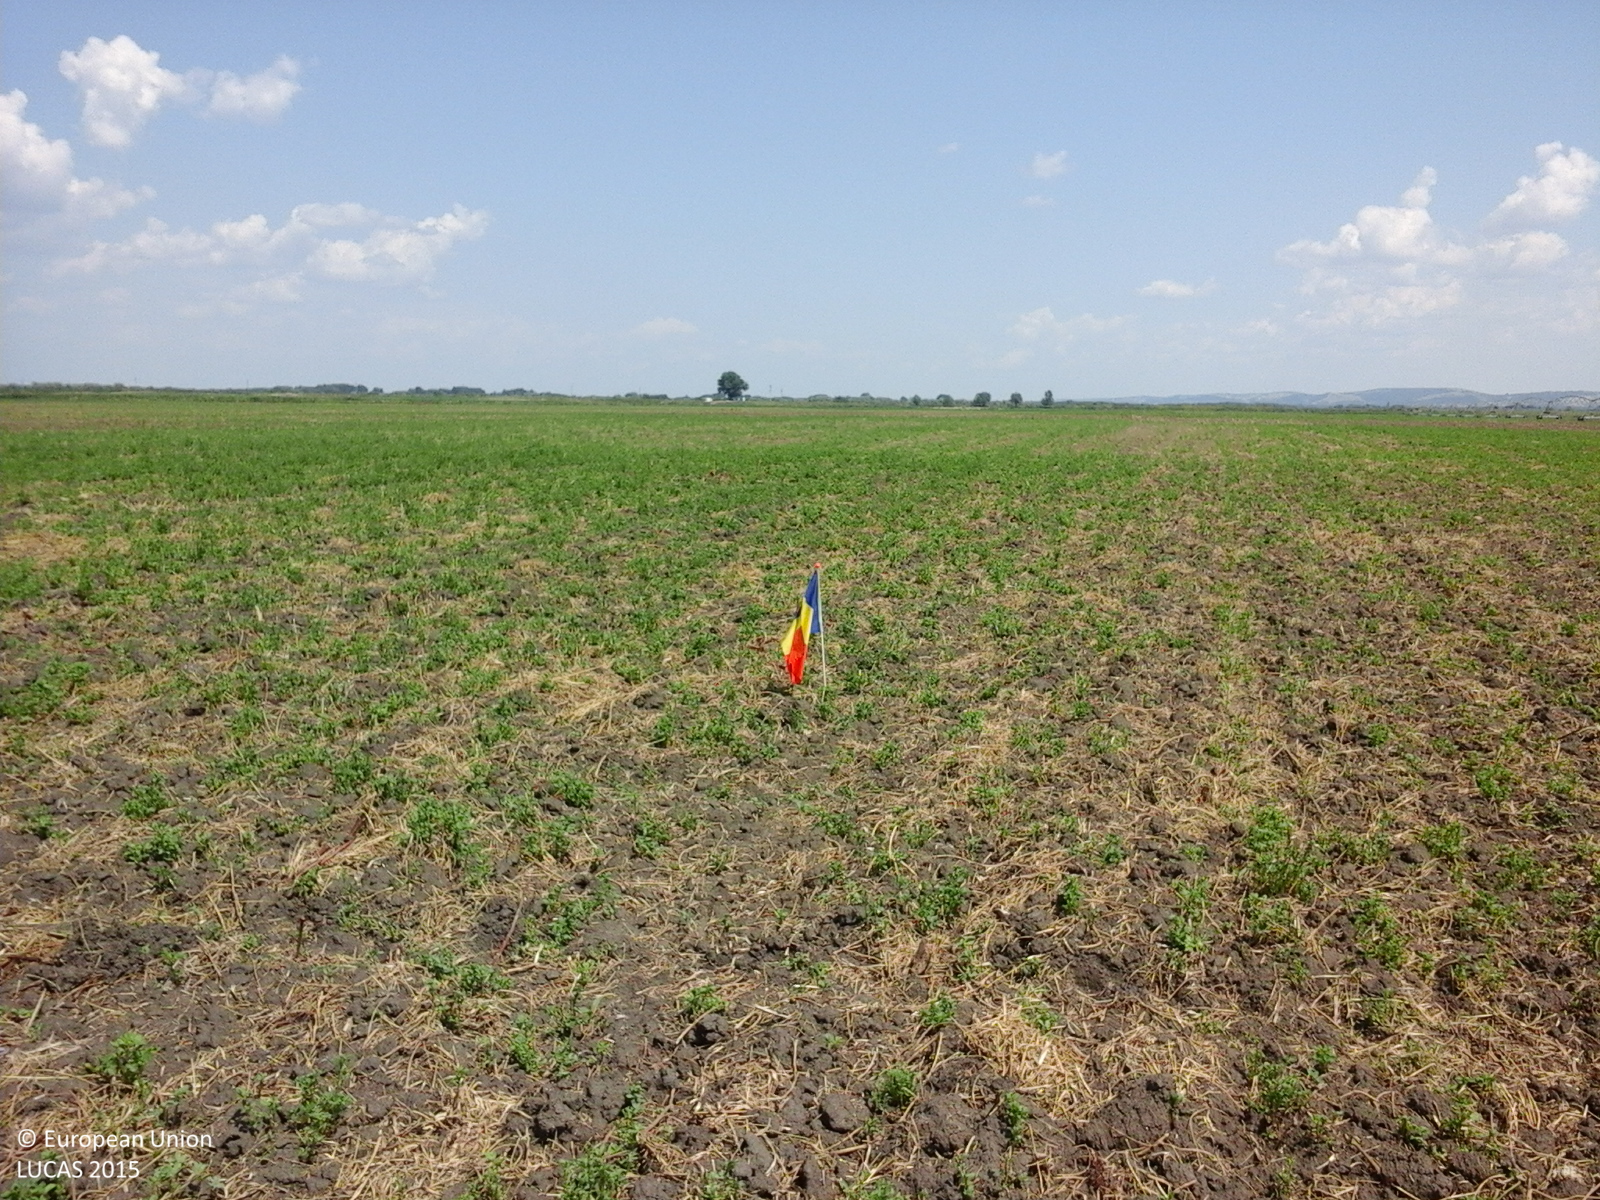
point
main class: Cropland
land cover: Clovers
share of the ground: 10 - 25 %
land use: Agriculture (excluding fallow land and kitchen gardens)
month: July
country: RO
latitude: 43.7266
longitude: 24.1221
